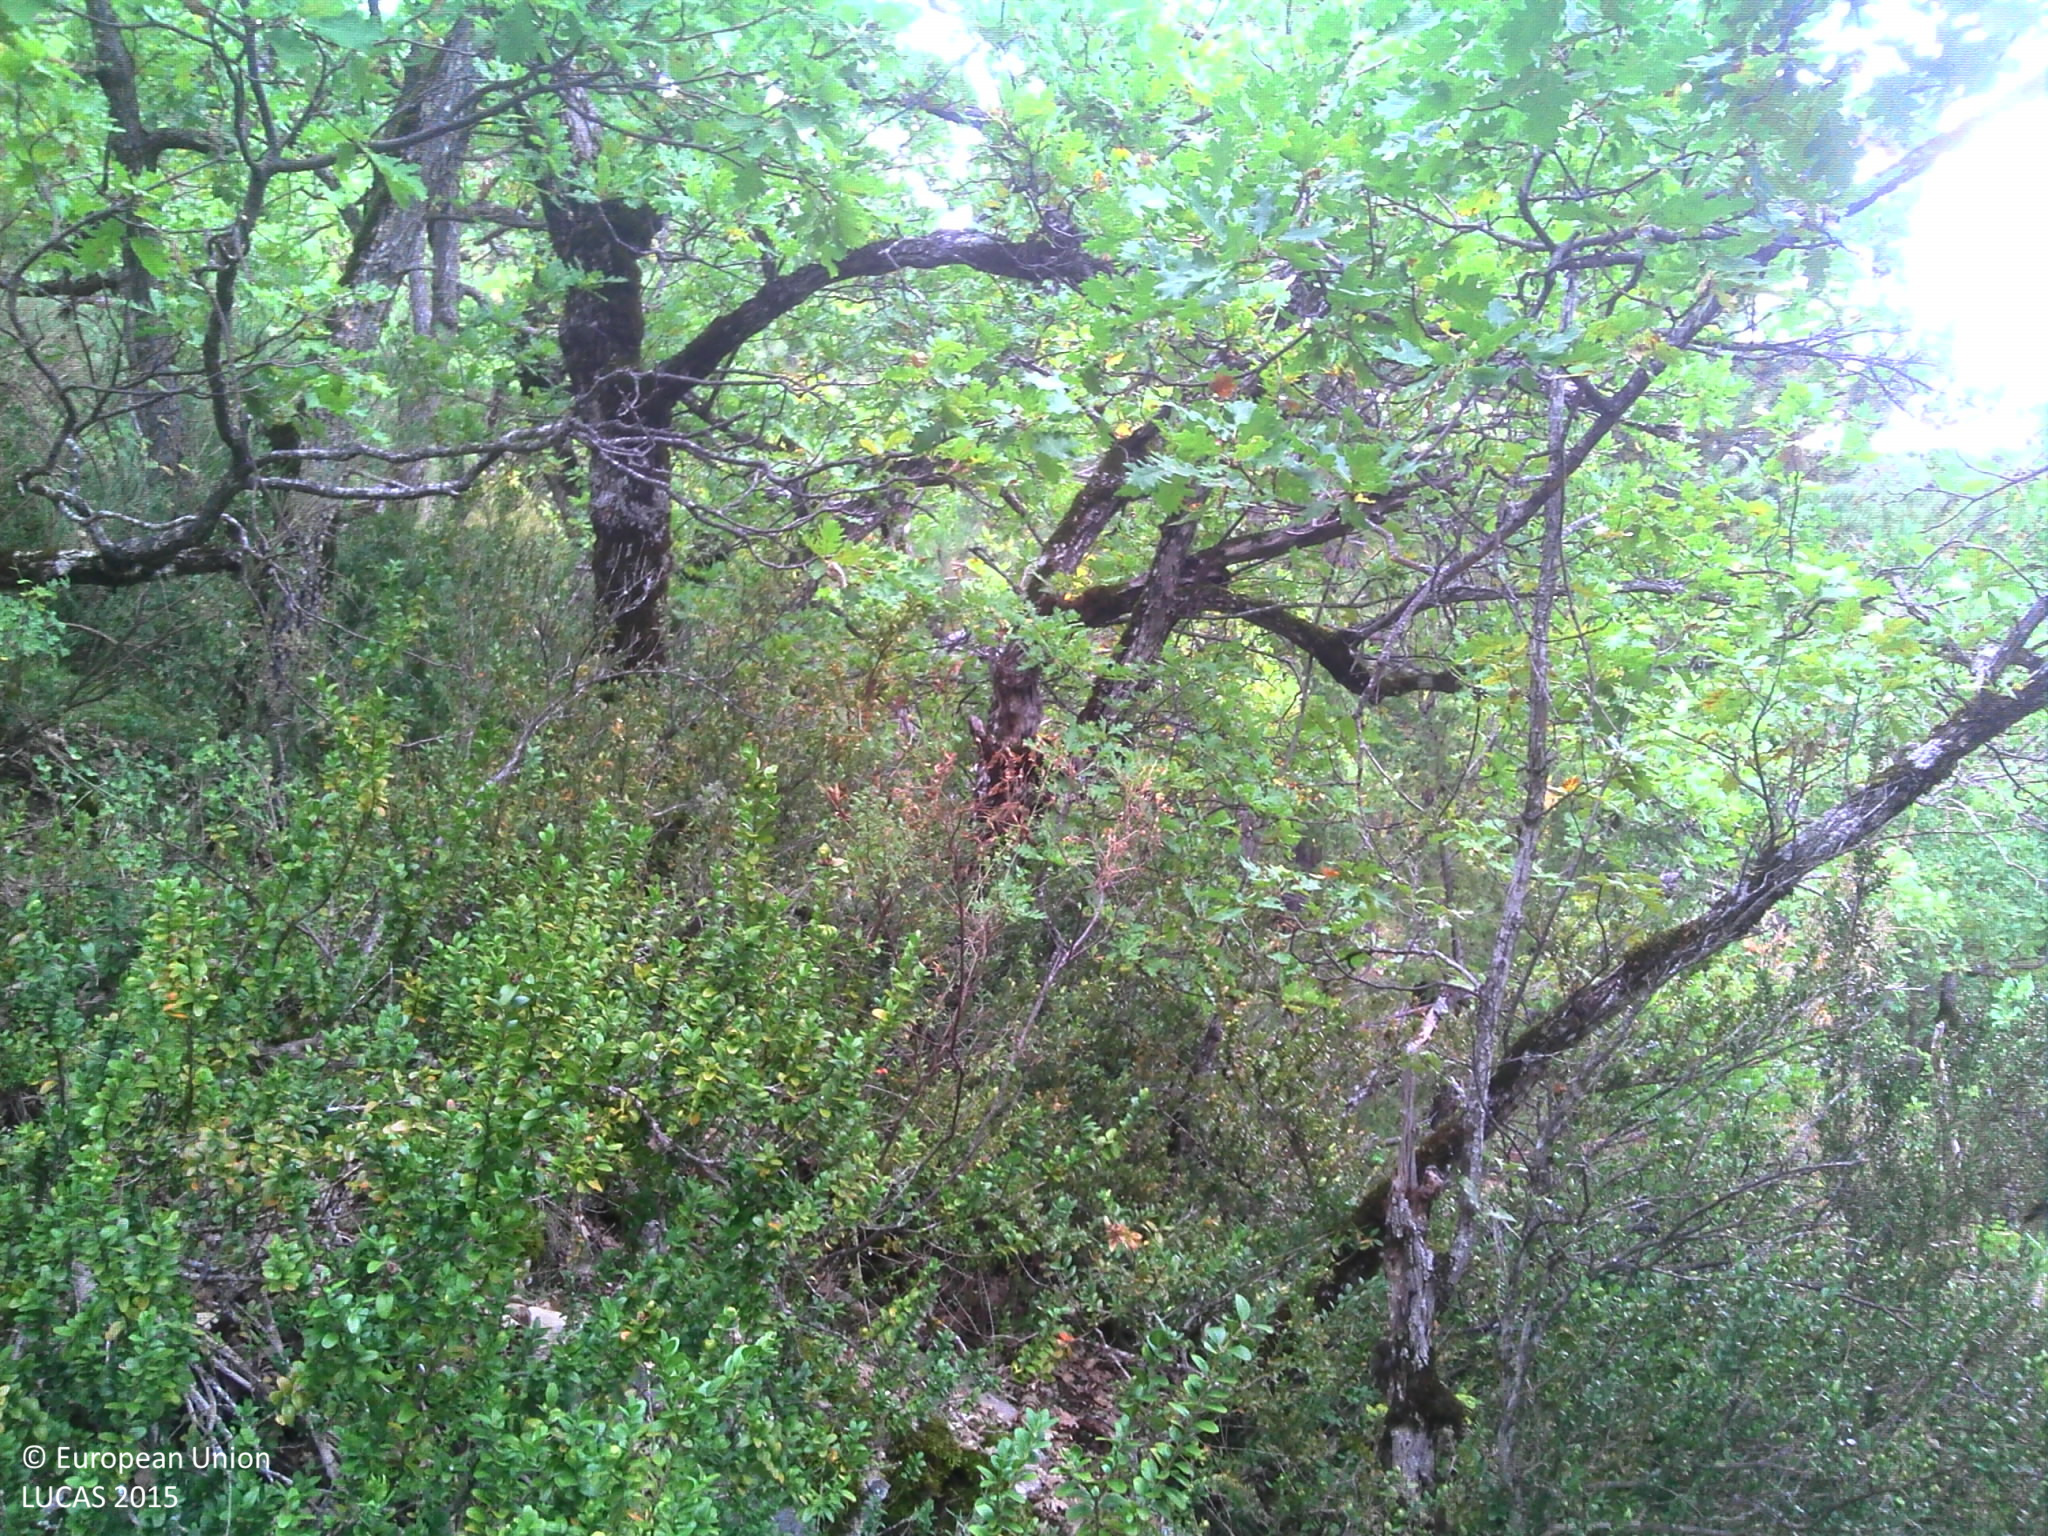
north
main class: Woodland
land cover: Pine dominated mixed woodland
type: coniferous forest of the mediterranean region
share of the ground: > 75 %
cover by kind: broadleaved forest trees 75 %, coniferous forest trees 25 %
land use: Forestry
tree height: > 5 m
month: September
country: FR
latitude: 44.5965
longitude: 5.5094
